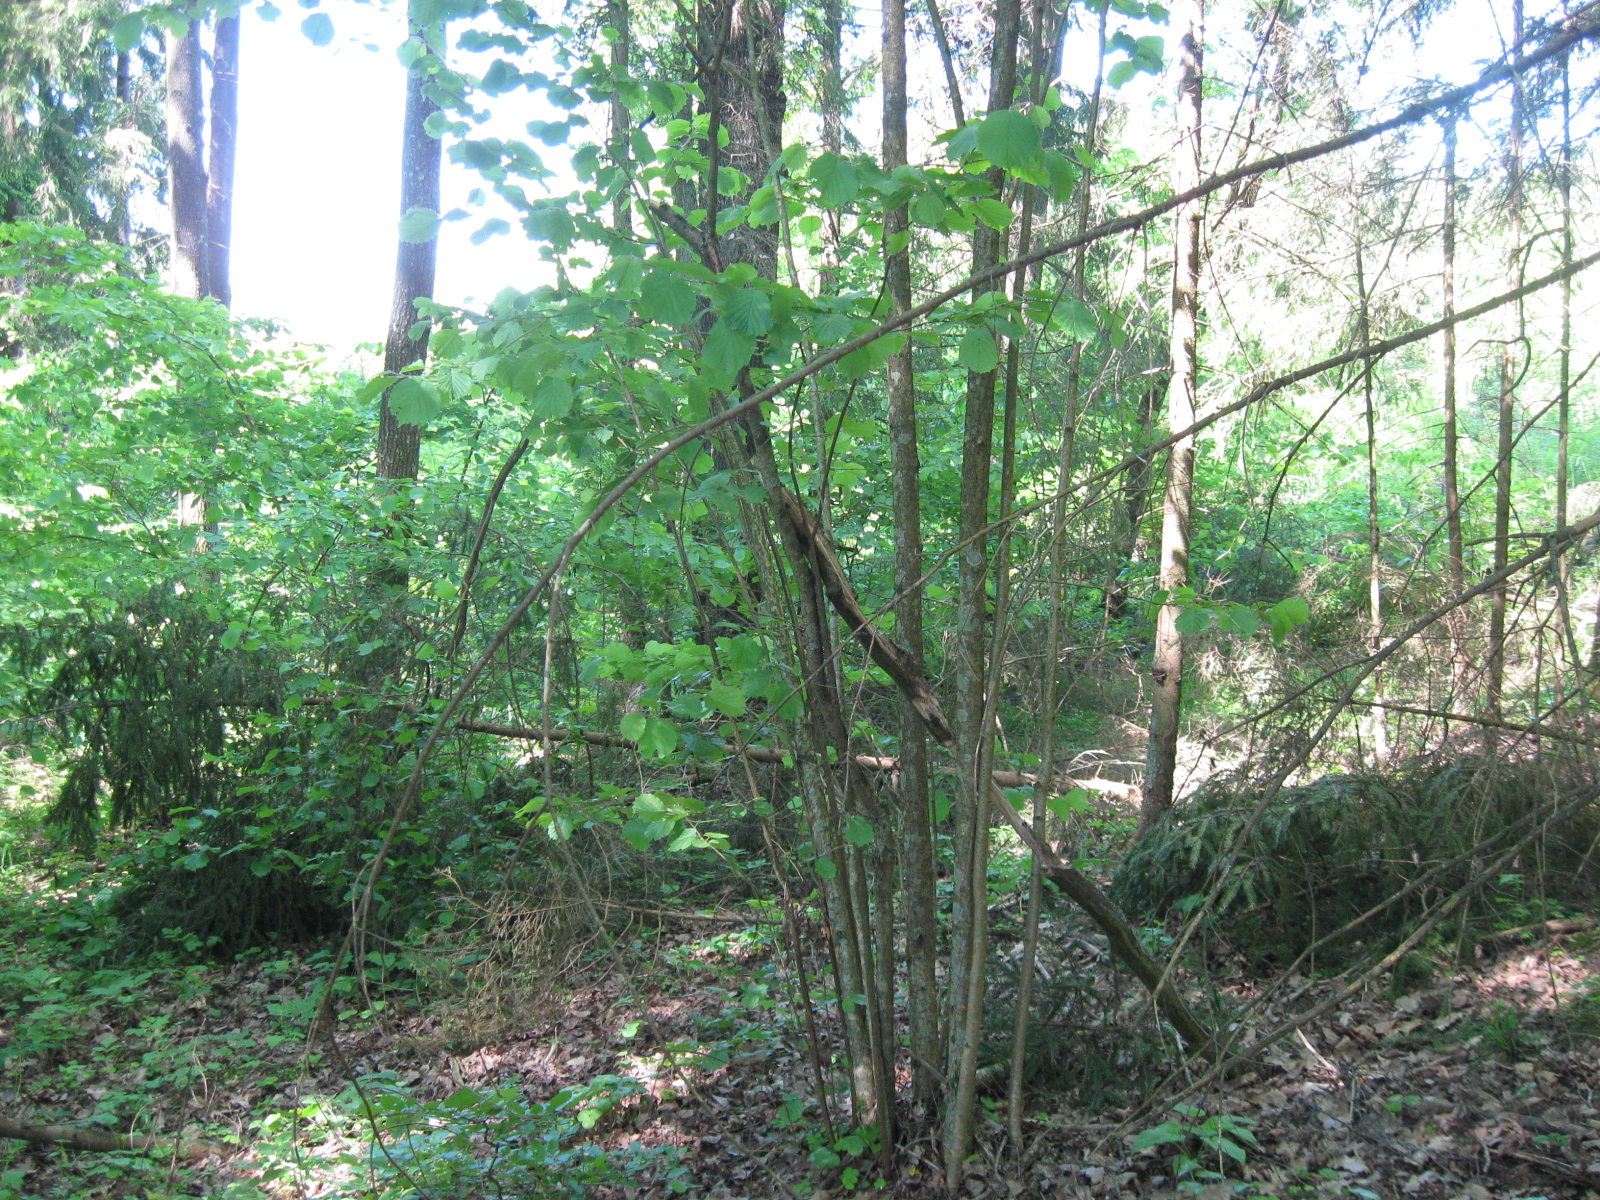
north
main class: Woodland
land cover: Spruce dominated mixed woodland
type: hemiboreal forest and nemoral coniferous forest and mixed broadleaved-coniferous forest
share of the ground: > 75 %
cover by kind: coniferous forest trees 55 %, broadleaved forest trees 45 %
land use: Forestry
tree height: > 5 m
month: June
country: LT
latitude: 54.1091
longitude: 23.5906
